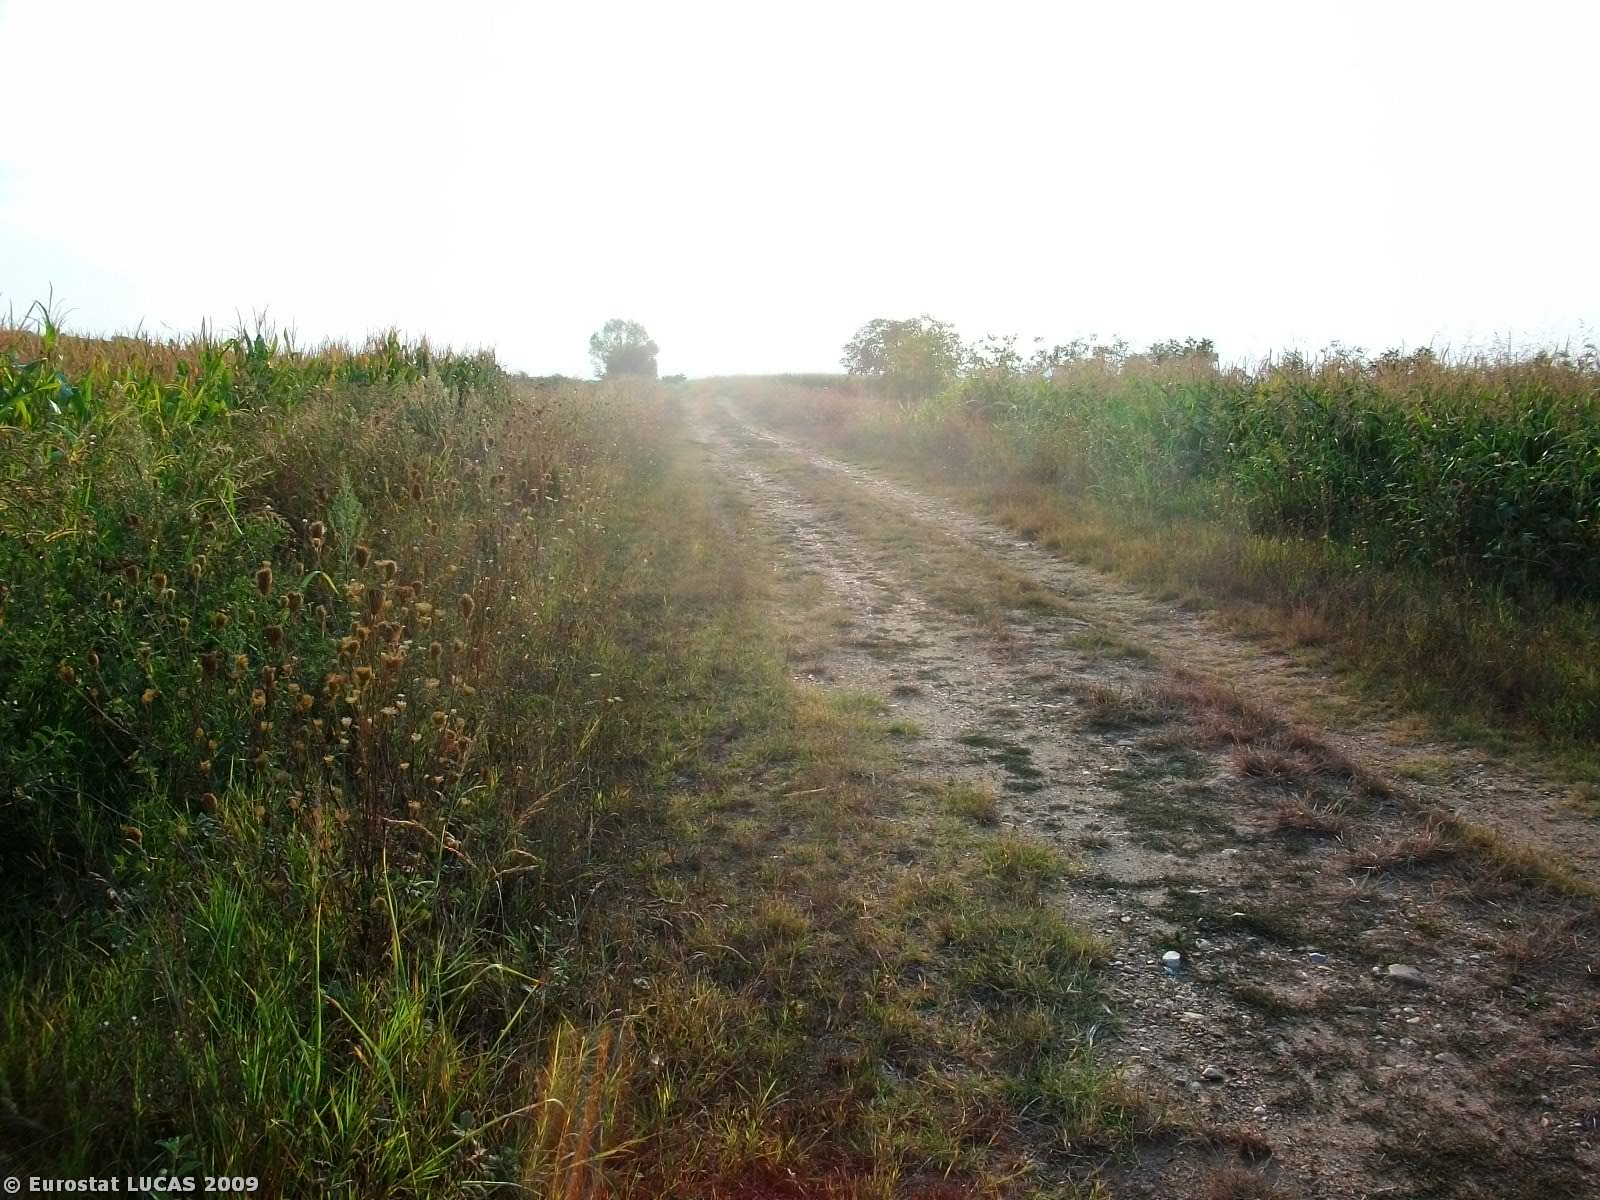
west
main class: Cropland
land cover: Maize
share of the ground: > 75 %
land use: Agriculture (excluding fallow land and kitchen gardens)
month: August
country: GR
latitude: 41.5860
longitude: 26.3789
